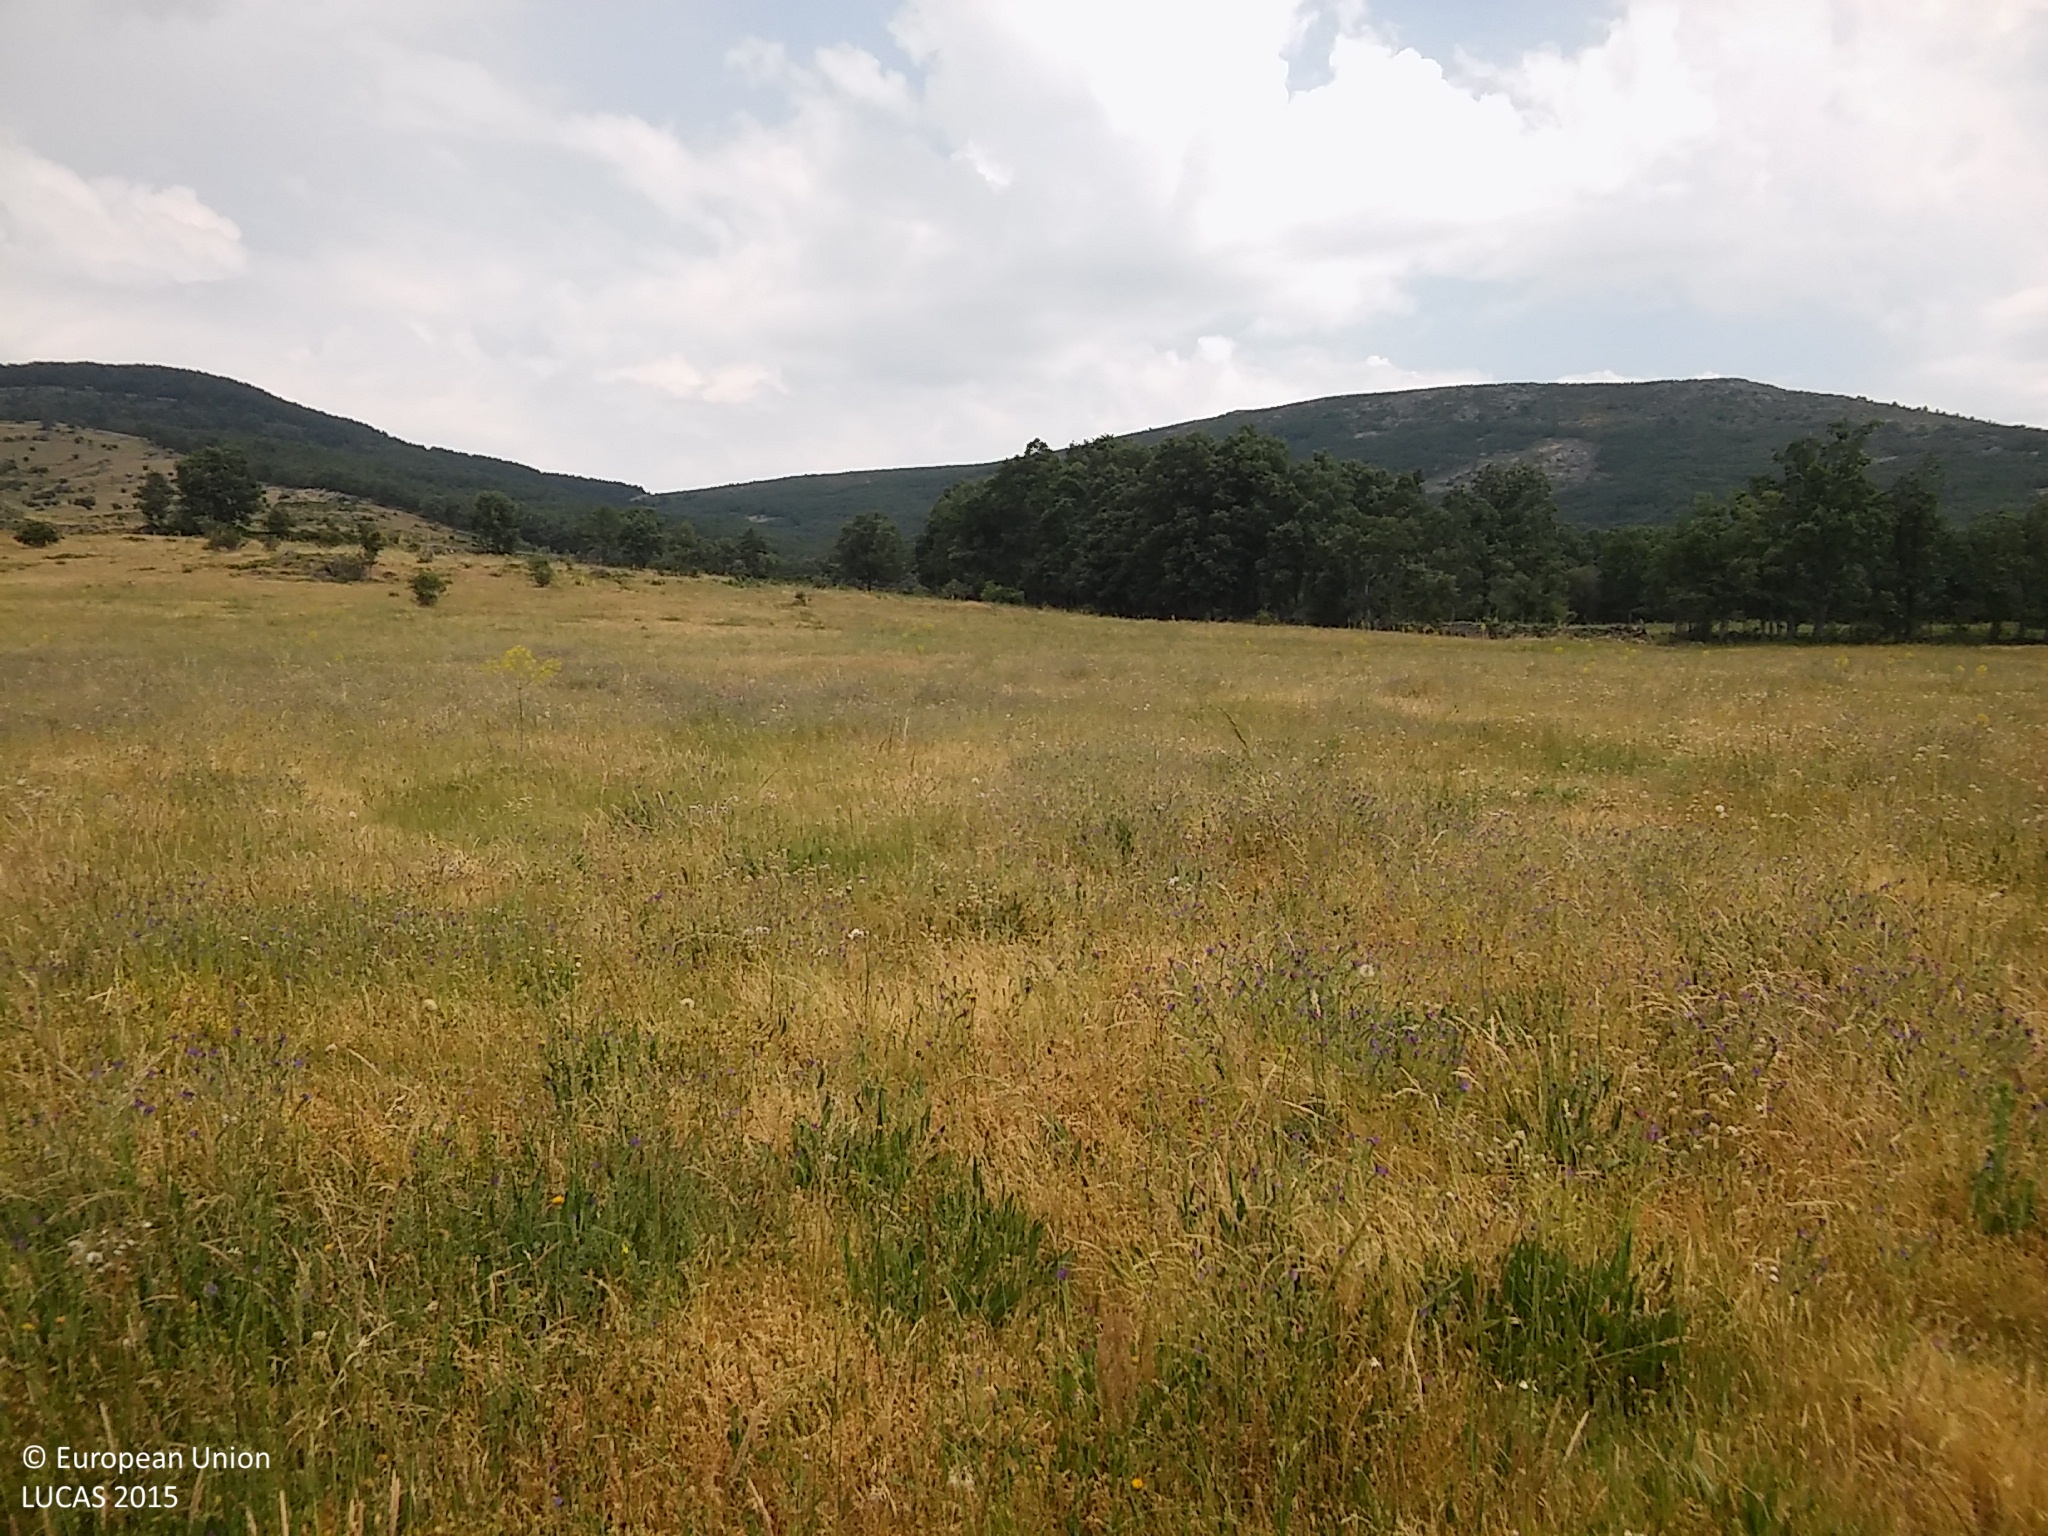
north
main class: Grassland
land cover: Grassland without tree/shrub cover
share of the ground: > 75 %
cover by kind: herbaceous plants 100 %
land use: Agriculture (excluding fallow land and kitchen gardens)
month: June
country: ES
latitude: 41.0490
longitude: -3.6433
